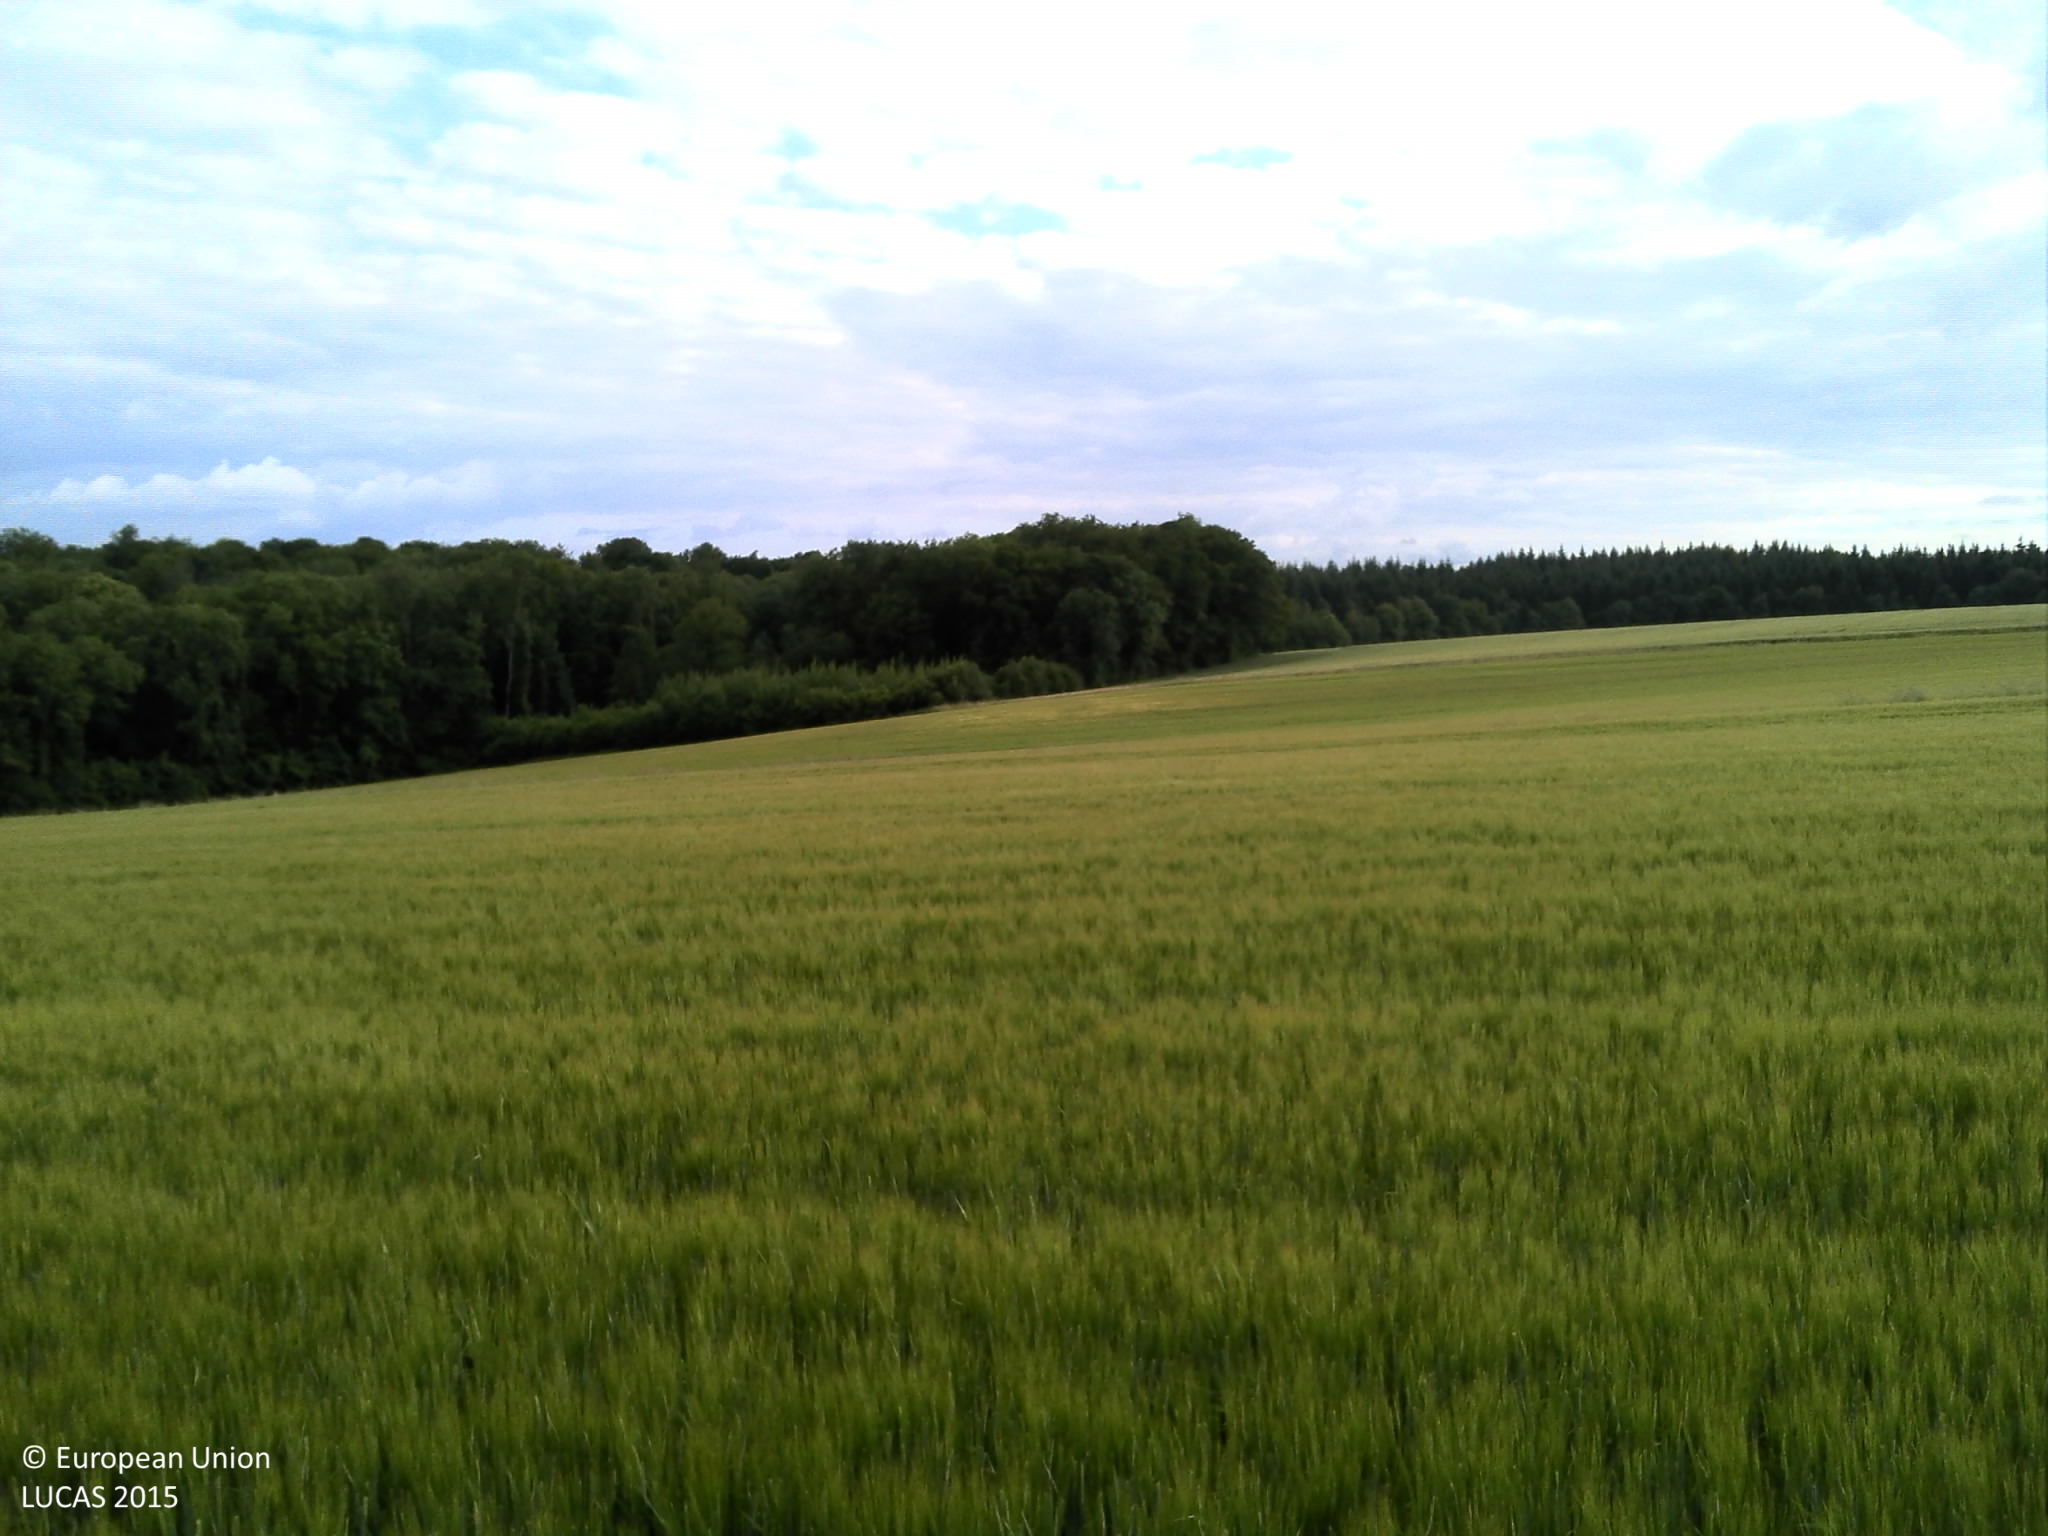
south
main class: Cropland
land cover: Barley
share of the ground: > 75 %
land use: Agriculture (excluding fallow land and kitchen gardens)
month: June
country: FR
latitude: 49.6513
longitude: 4.8029
